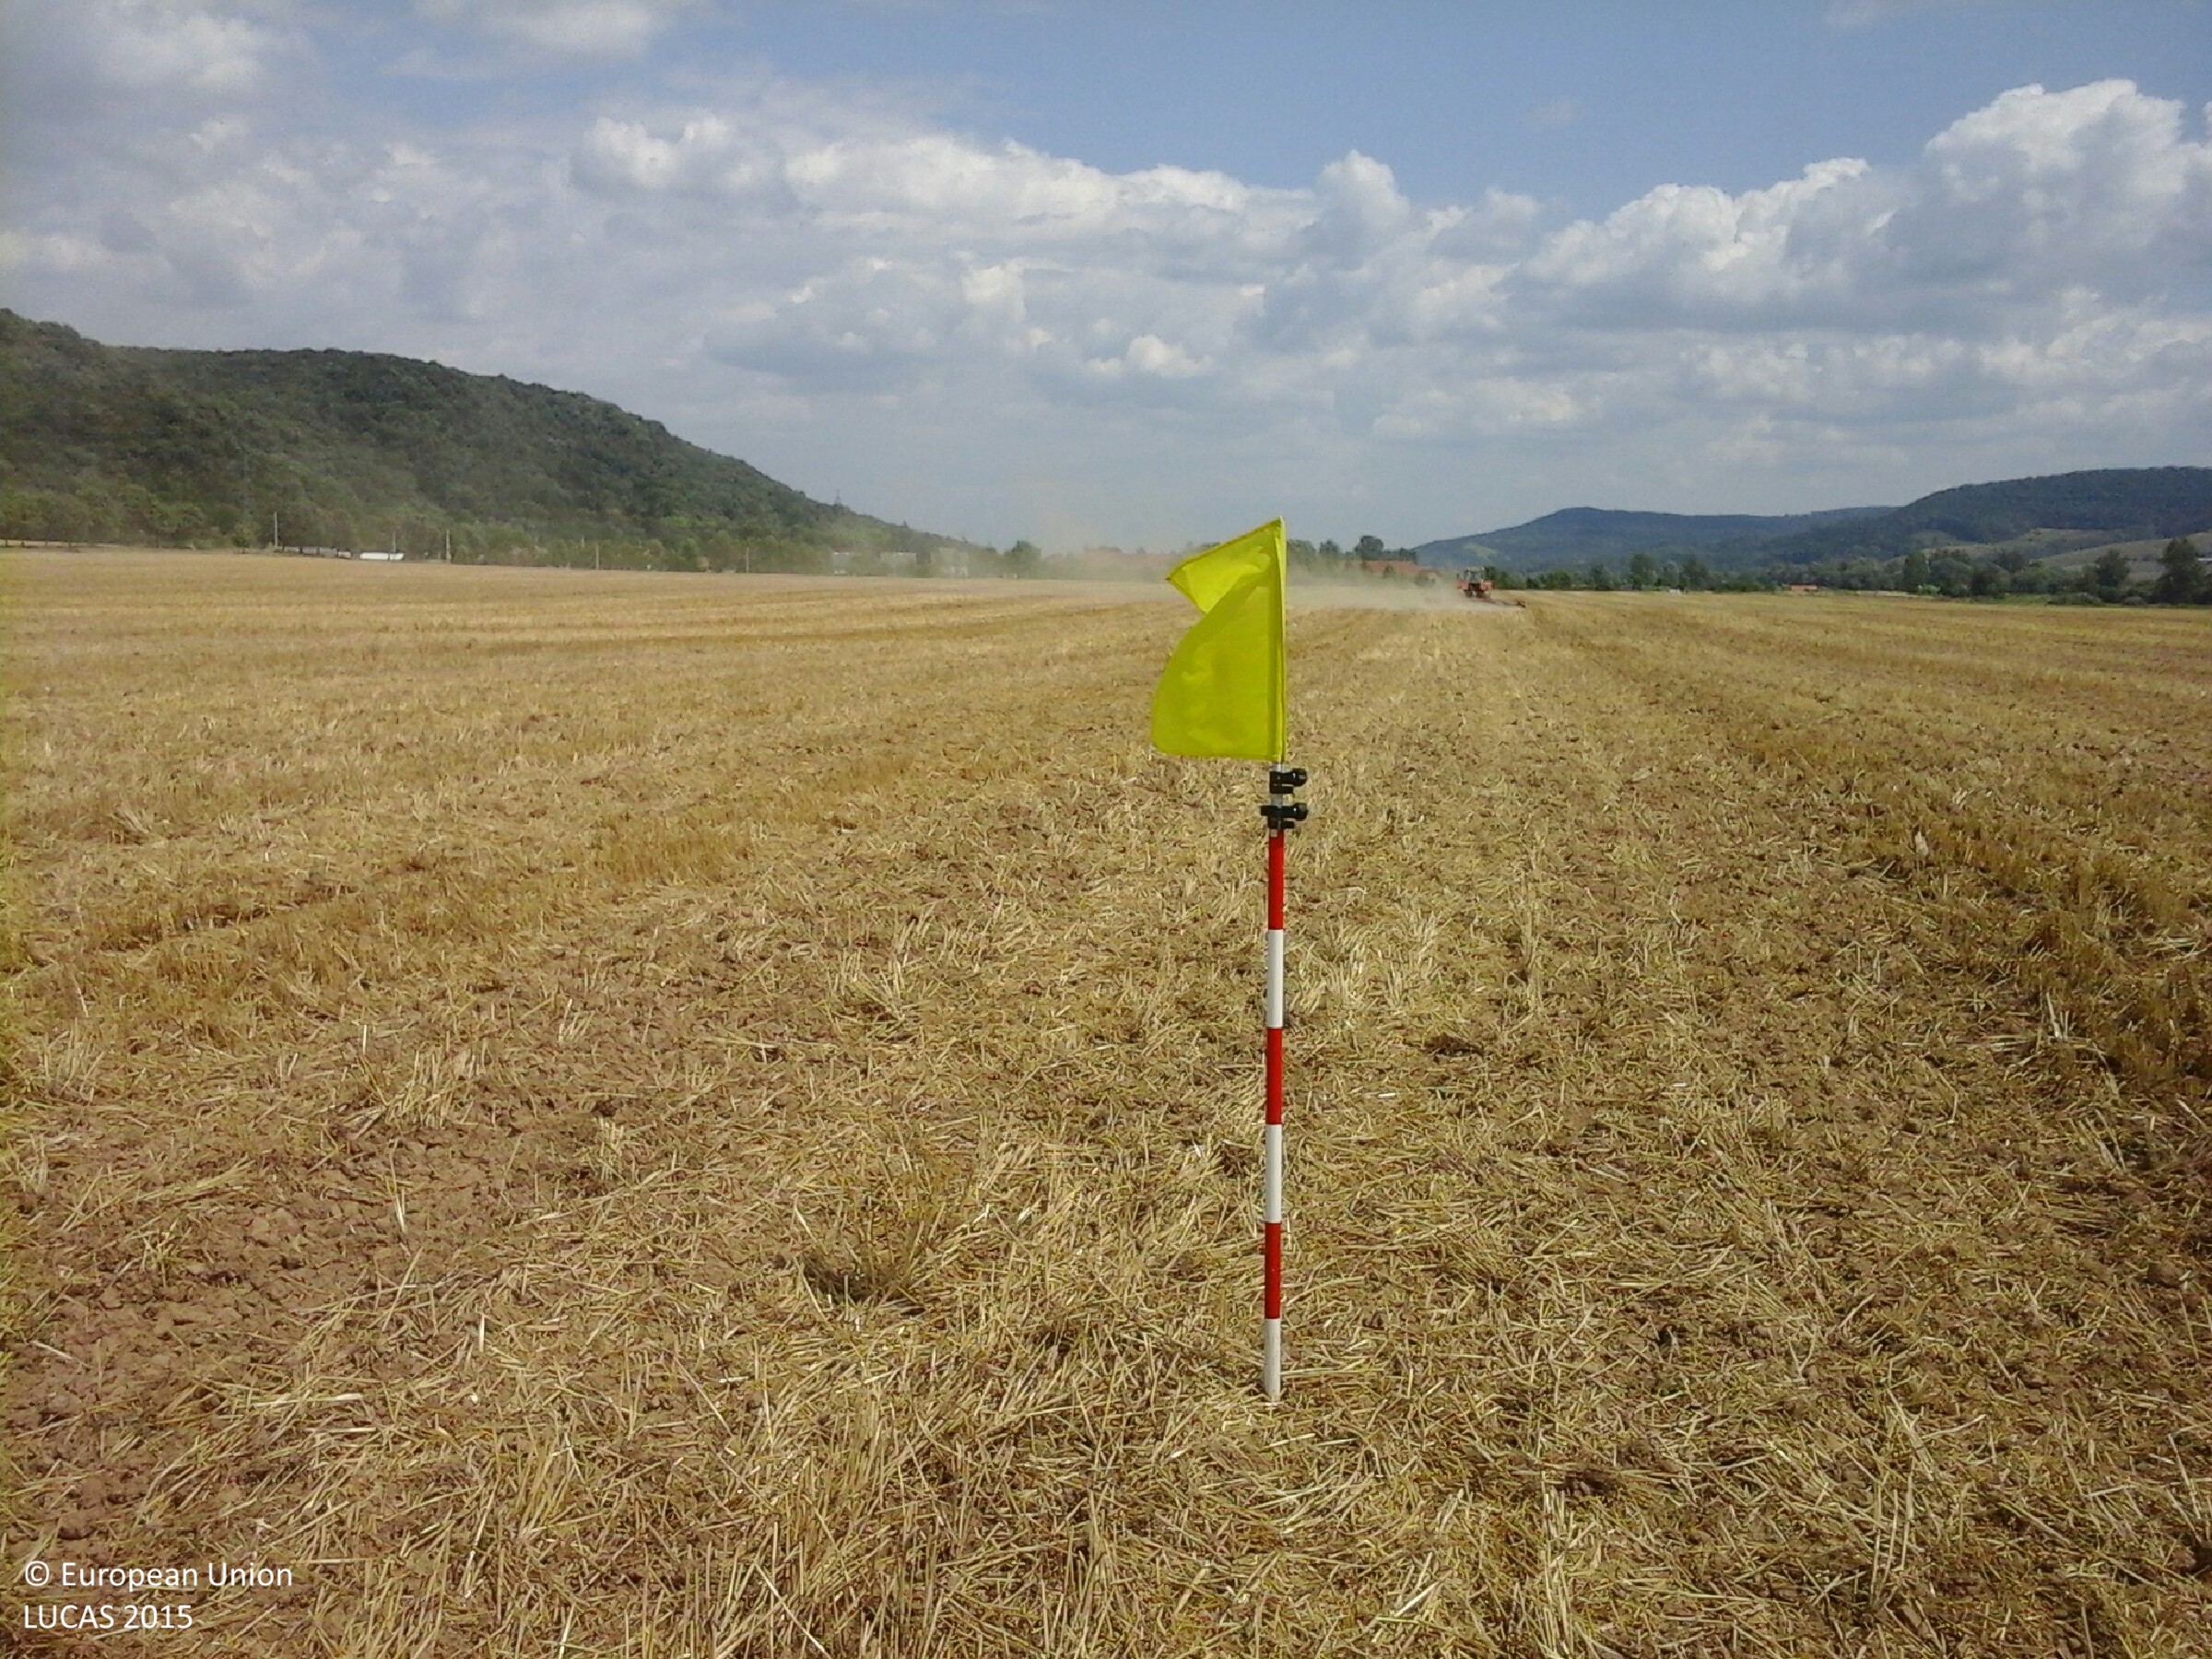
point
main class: Cropland
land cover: Common wheat
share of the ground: 25 - 50 %
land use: Agriculture (excluding fallow land and kitchen gardens)
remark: Harvested field
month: July
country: HU
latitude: 48.2852
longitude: 20.4785
